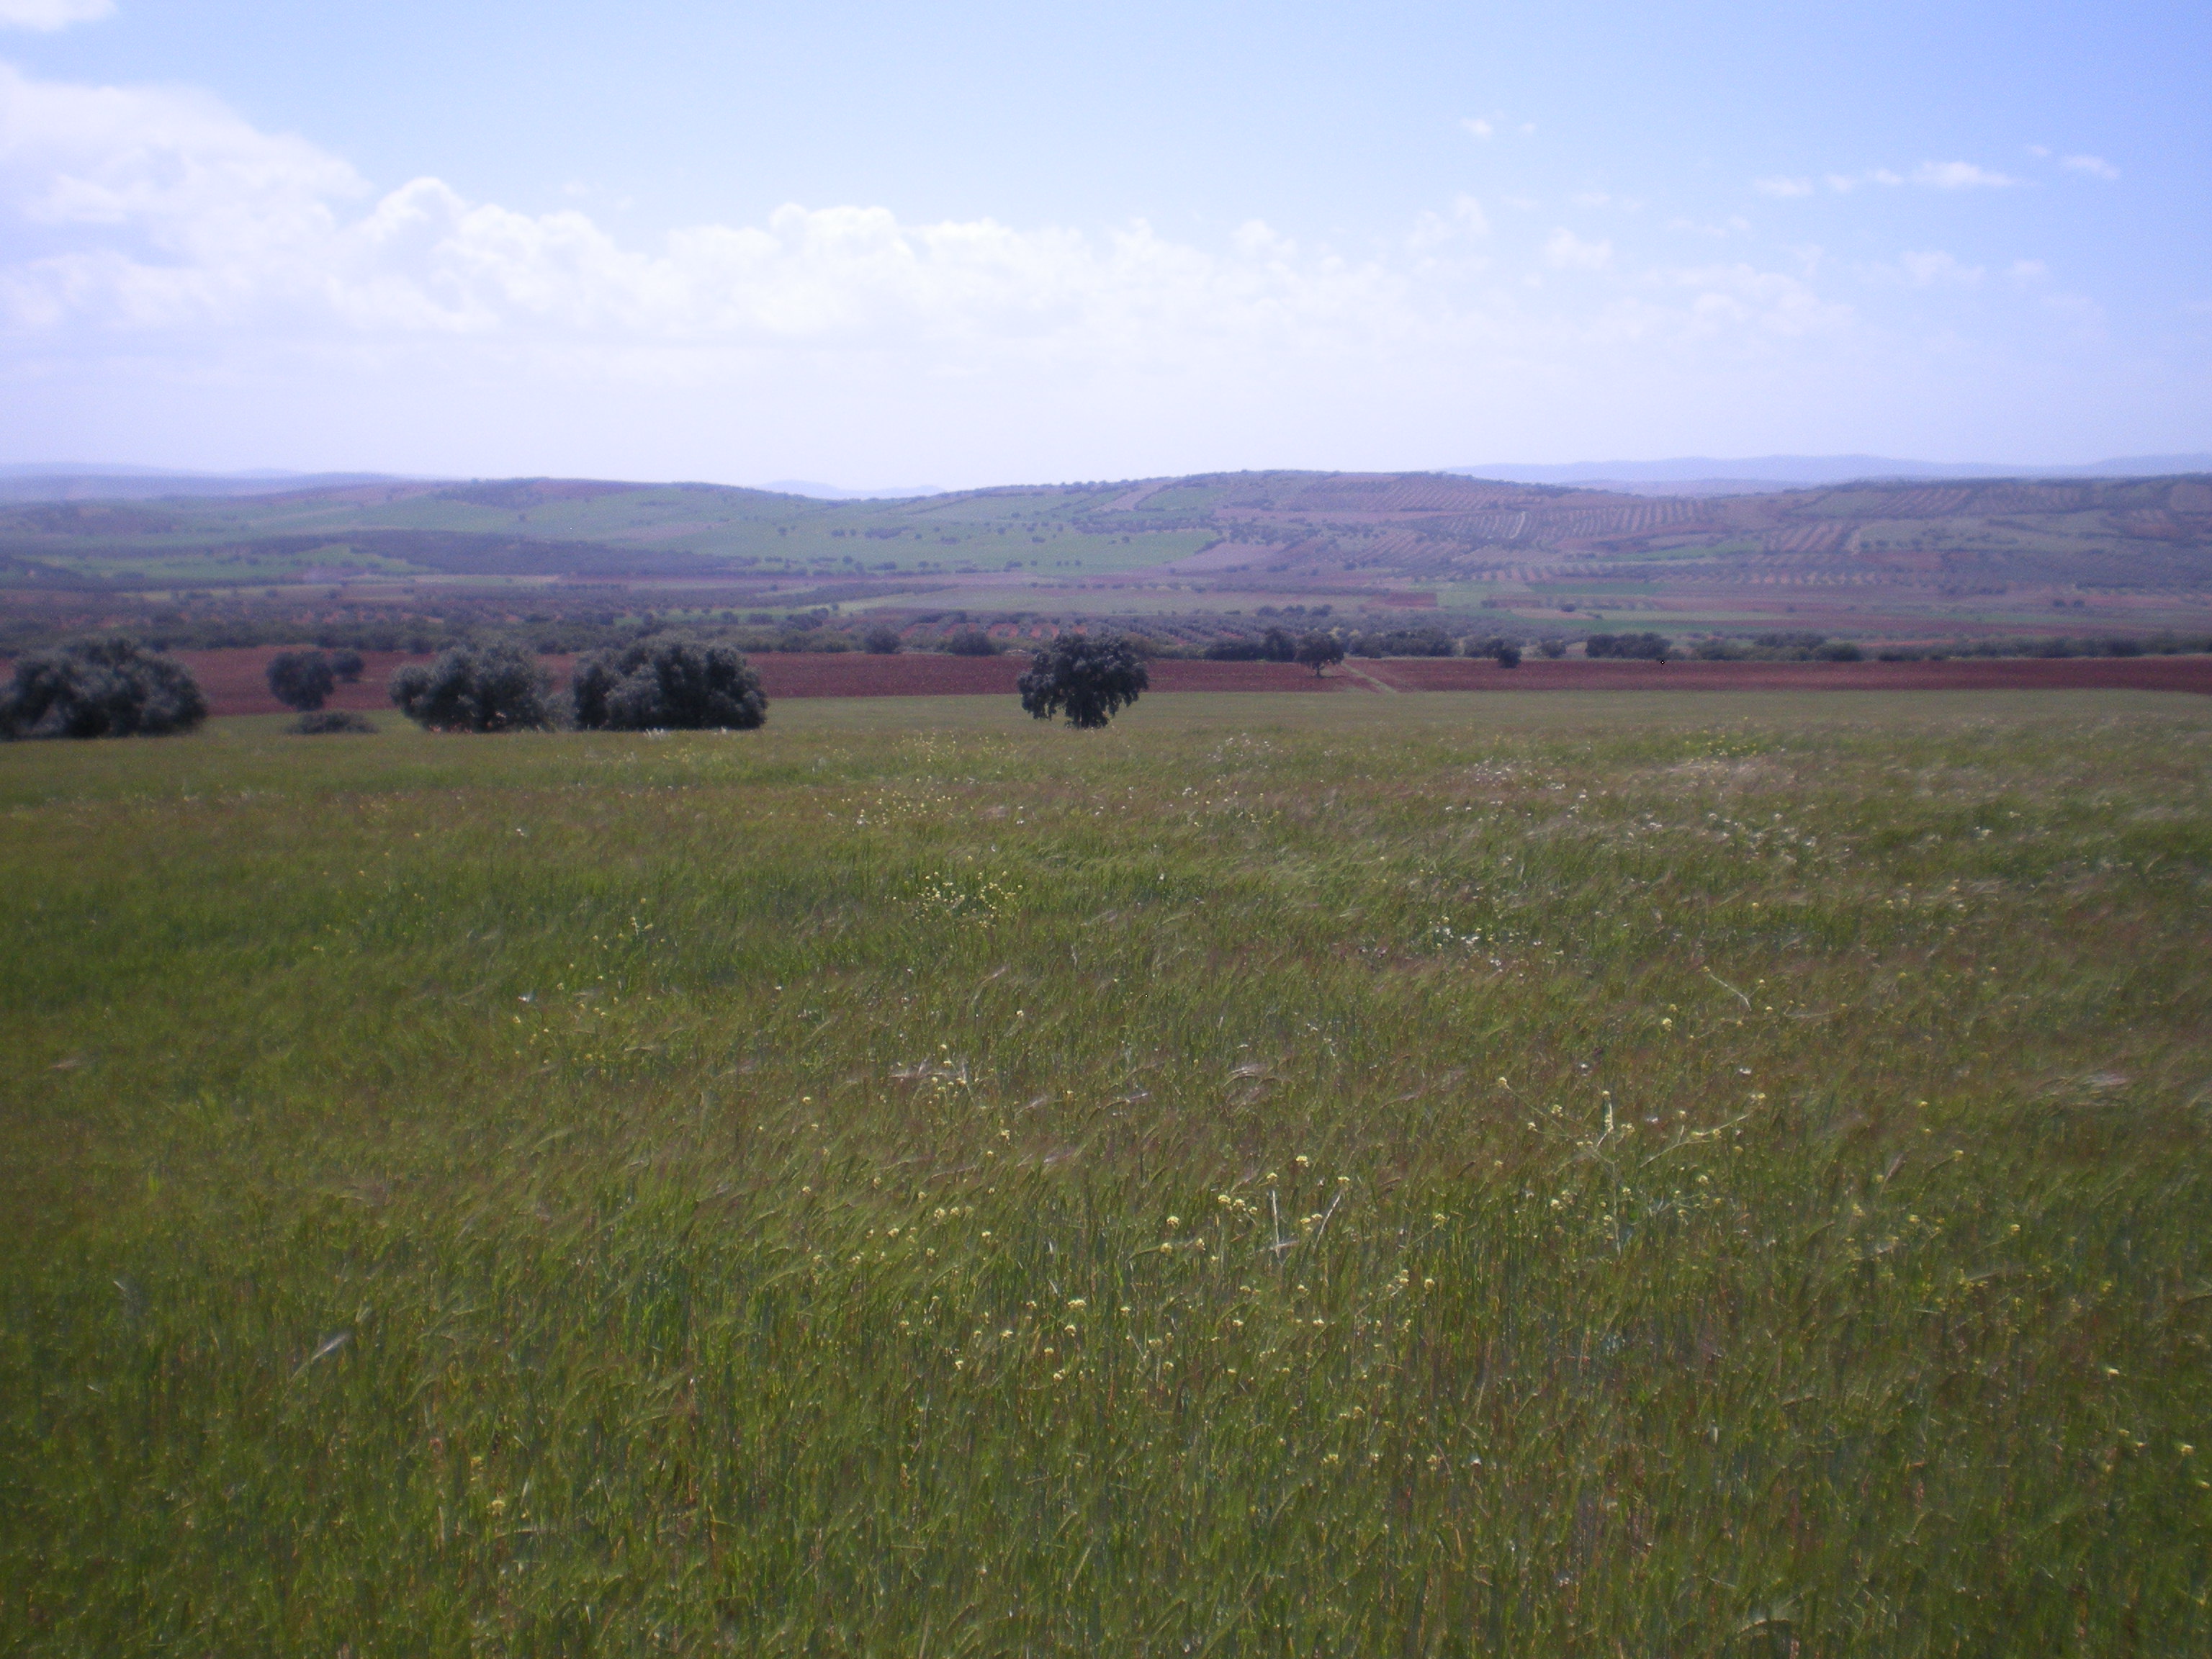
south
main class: Cropland
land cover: Barley
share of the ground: > 75 %
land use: Agriculture (excluding fallow land and kitchen gardens)
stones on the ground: 10 - 25 %
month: April
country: ES
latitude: 38.5575
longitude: -3.5162
